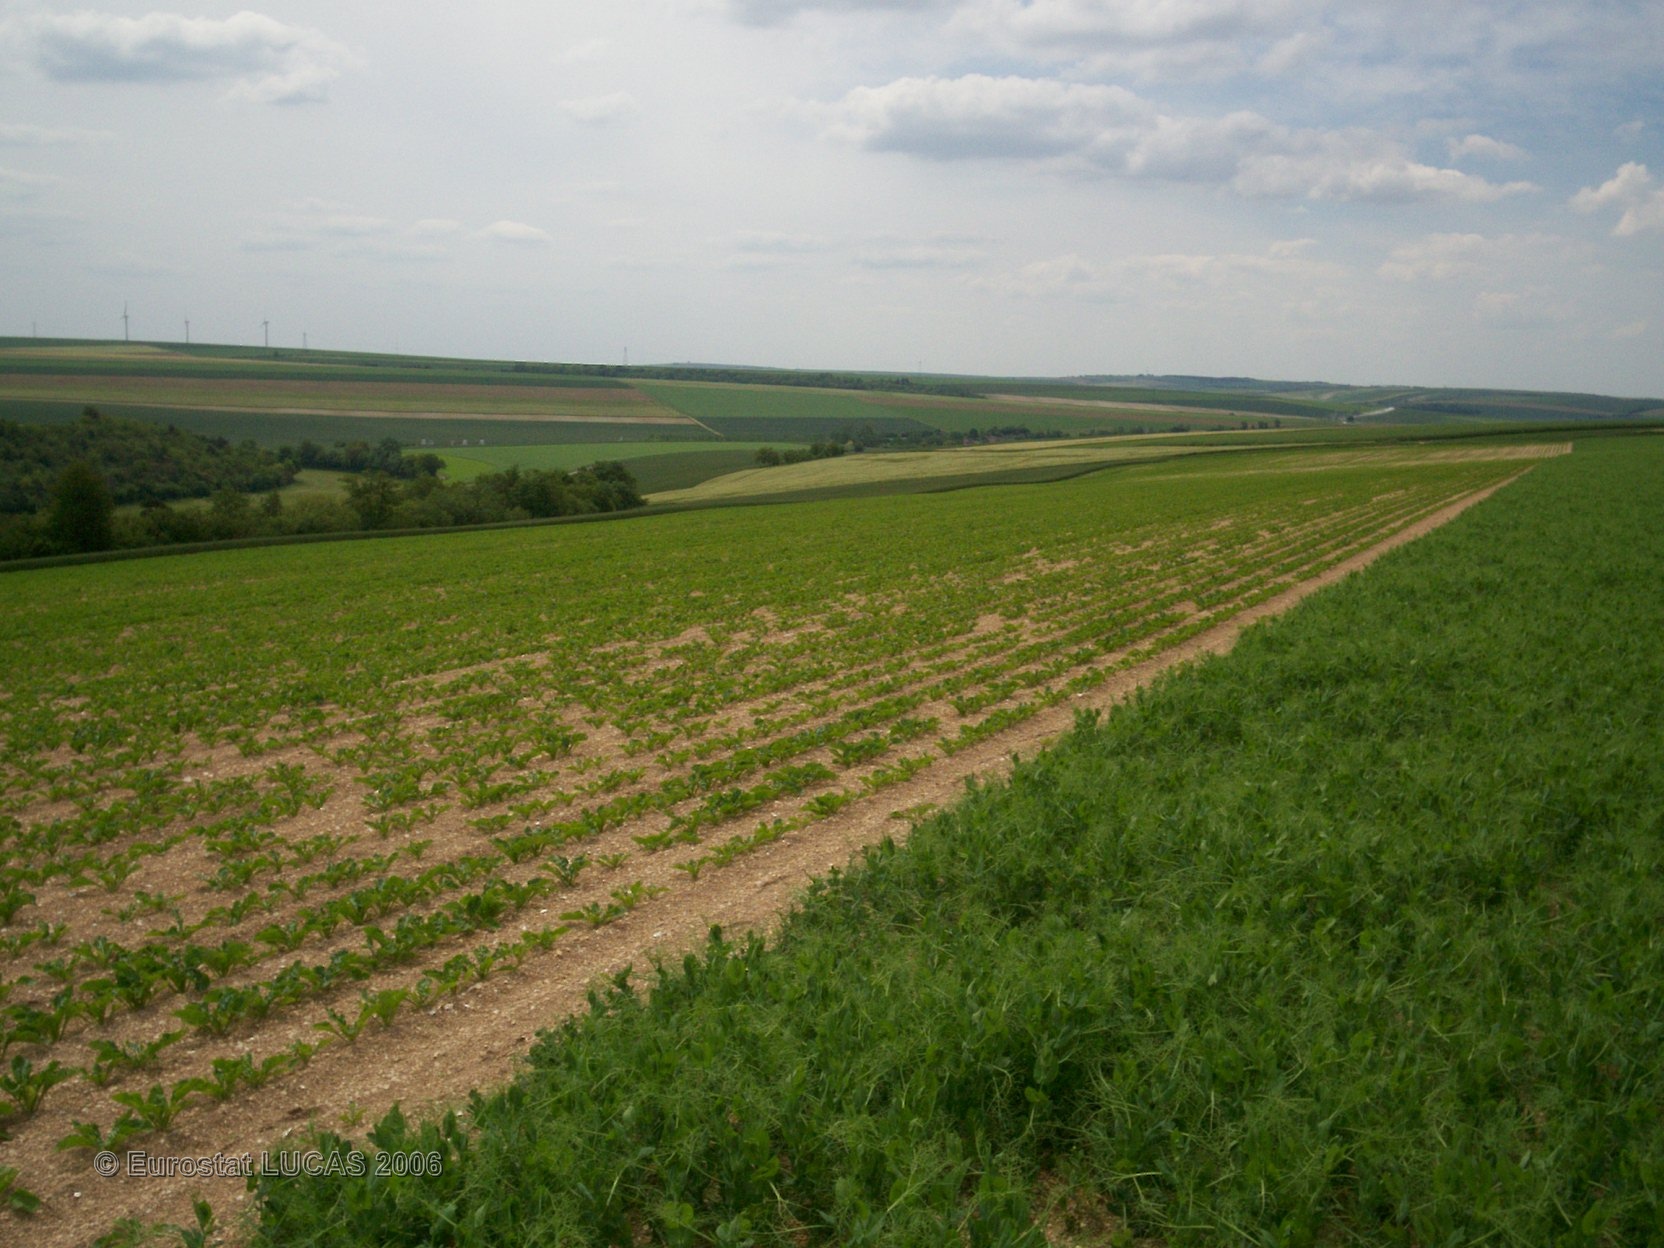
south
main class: Cropland
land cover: Dry pulses
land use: Agriculture (excluding fallow land and kitchen gardens)
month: June
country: FR
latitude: 48.8493
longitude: 4.6142
